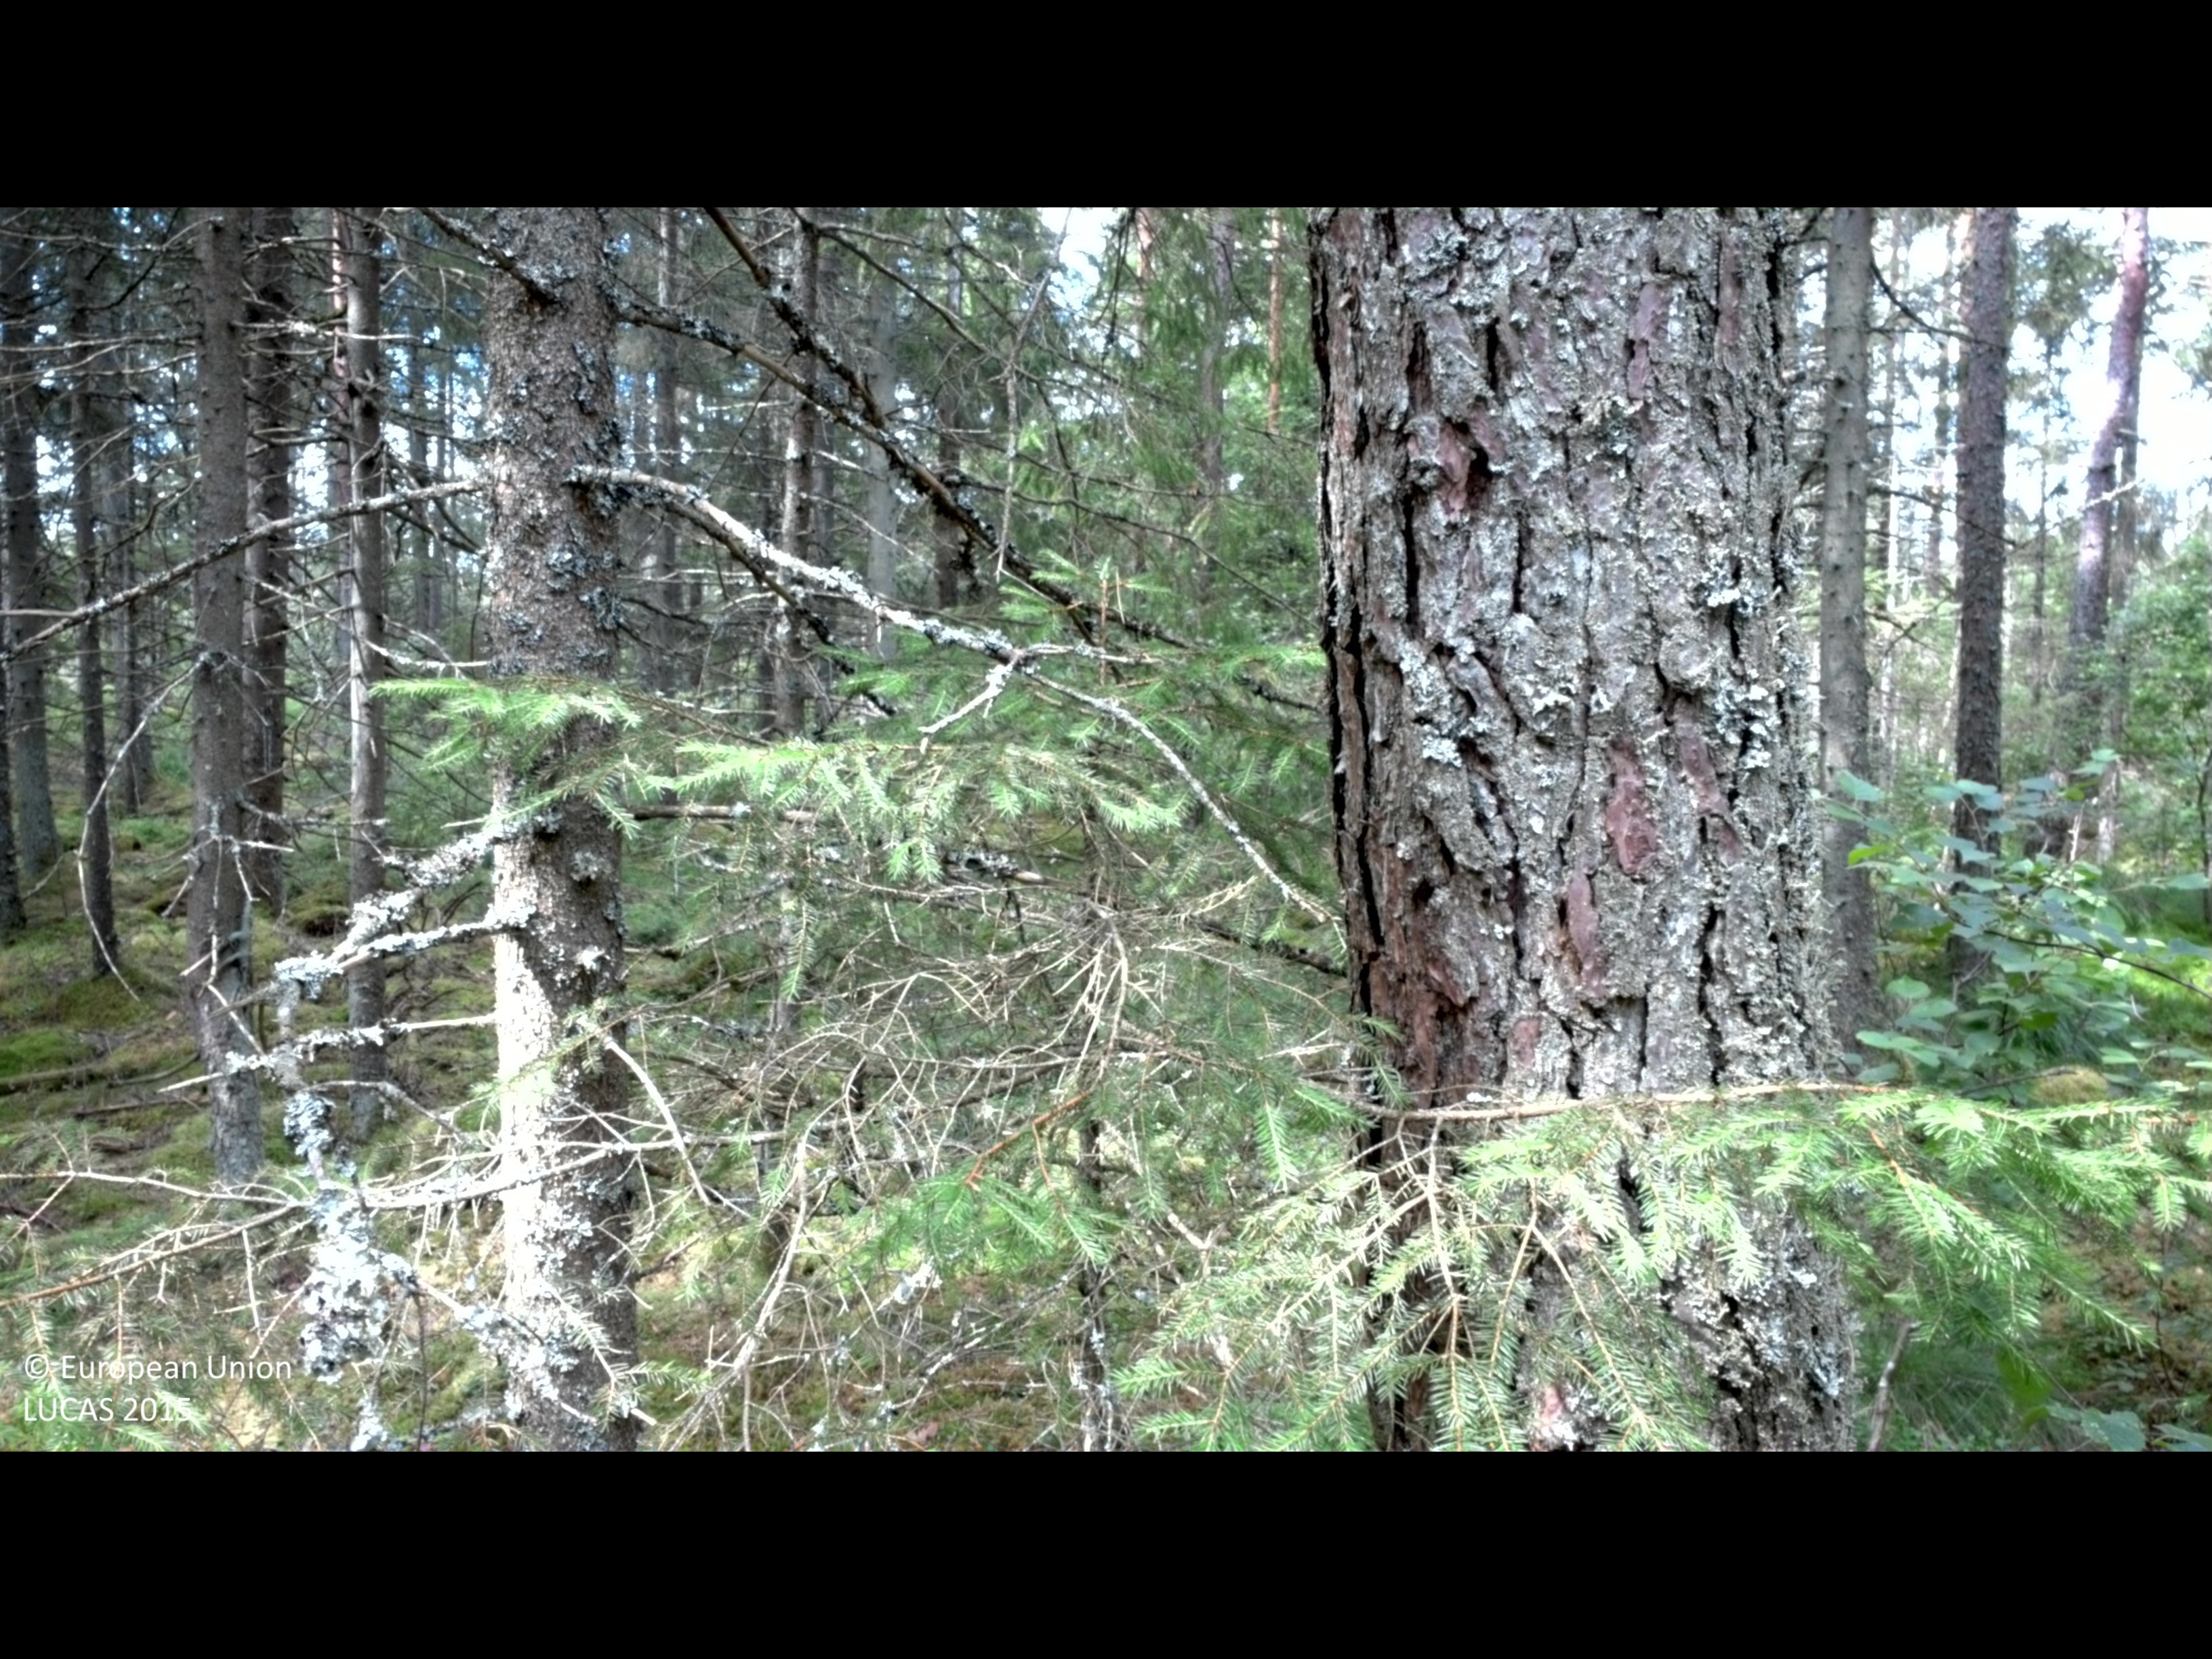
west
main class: Woodland
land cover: Spruce dominated coniferous woodland
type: boreal forest
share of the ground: > 75 %
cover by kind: coniferous forest trees 80 %, herbaceous plants 10 %, broadleaved forest trees 5 %, shrubs 5 %
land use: Forestry
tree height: > 5 m
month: August
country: SE
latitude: 56.7443
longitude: 13.7737
